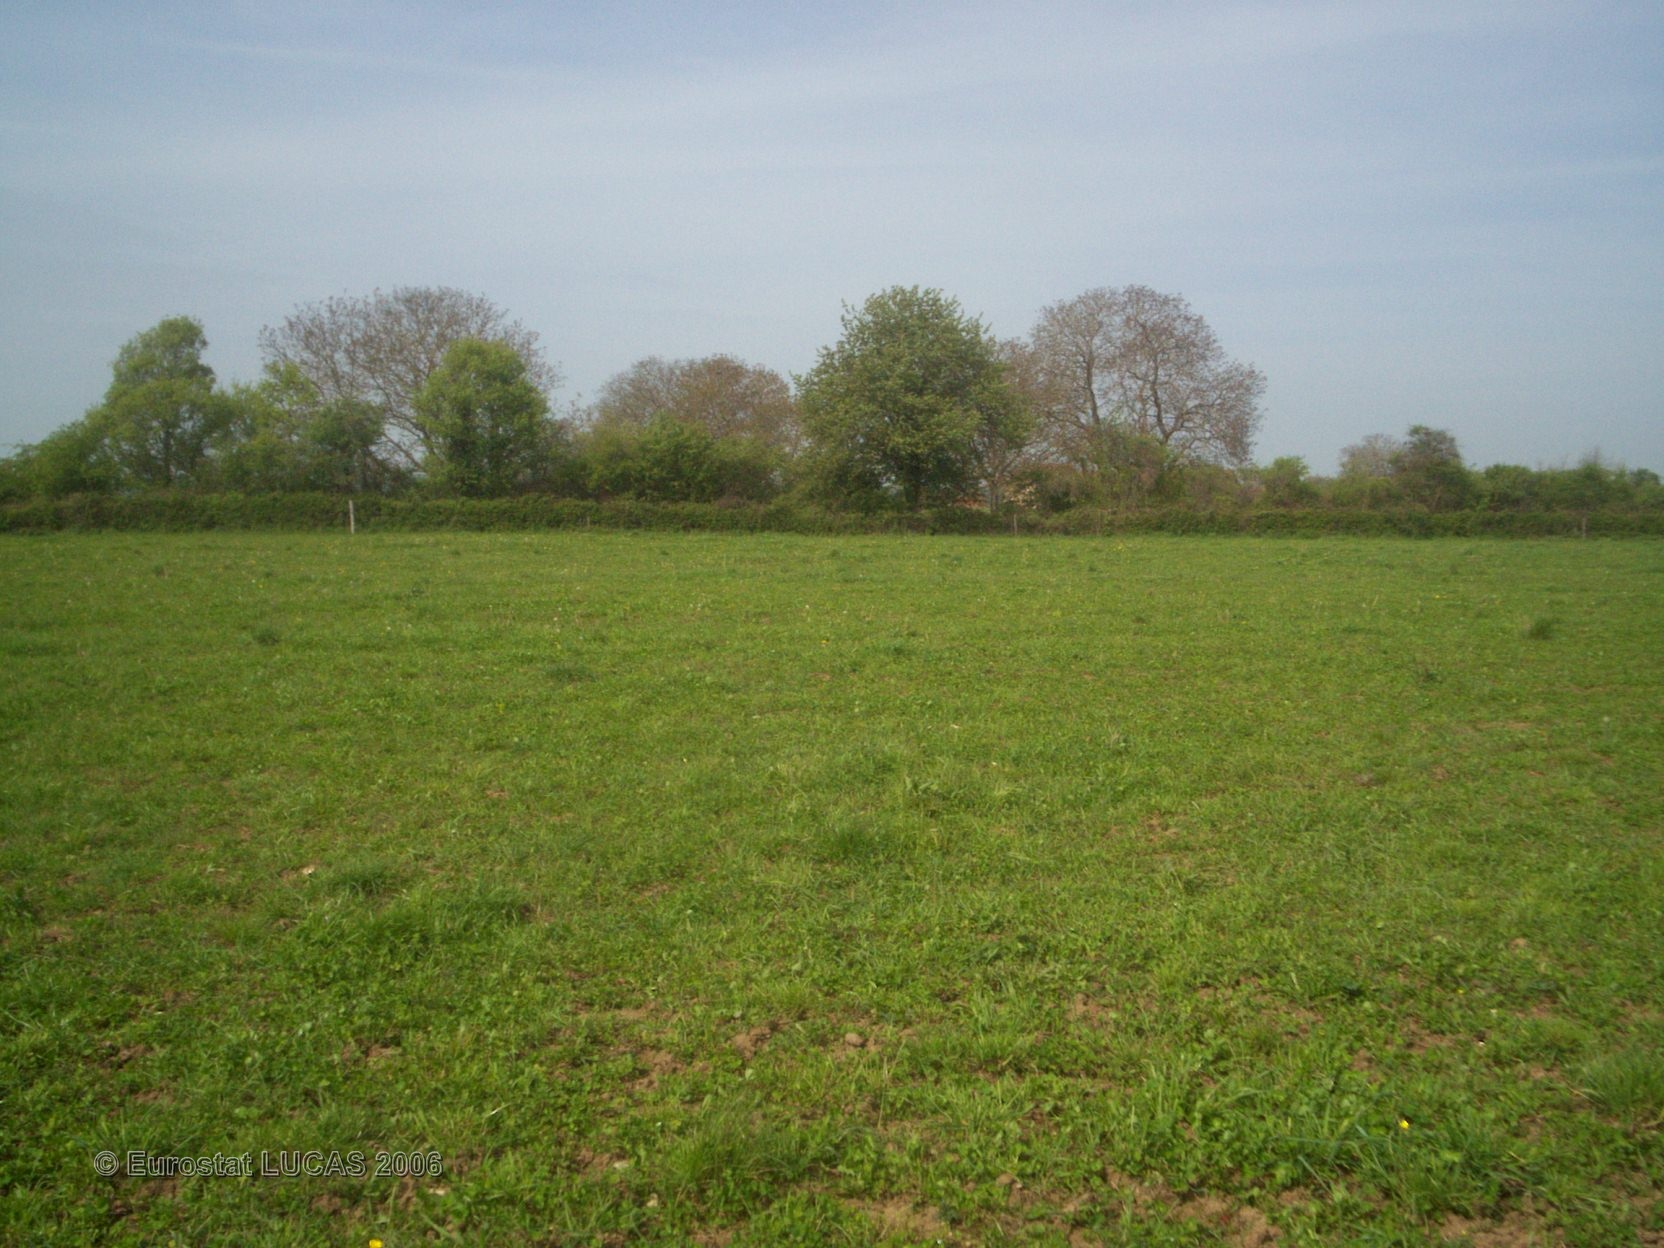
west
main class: Grassland
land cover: Grassland without tree/shrub cover
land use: Agriculture (excluding fallow land and kitchen gardens)
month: May
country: FR
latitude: 46.5472
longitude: 3.1507
